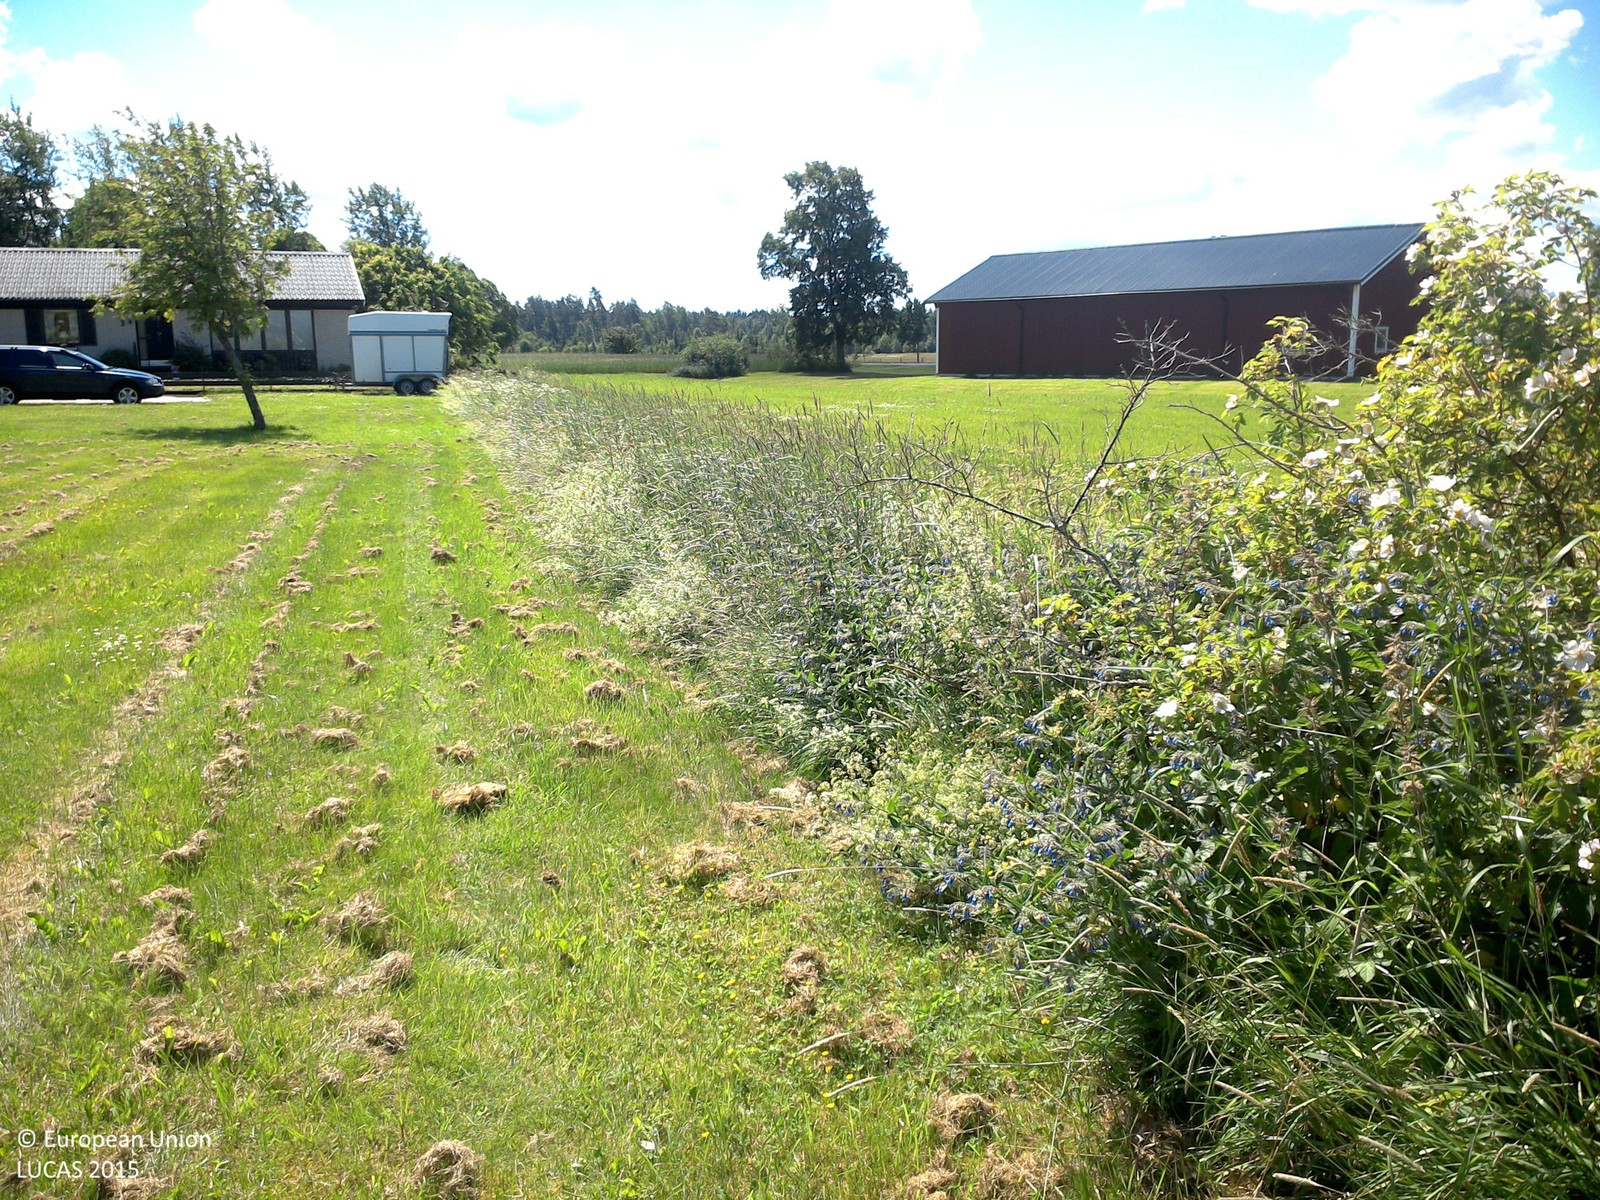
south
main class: Grassland
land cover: Grassland without tree/shrub cover
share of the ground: > 75 %
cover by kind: herbaceous plants 100 %
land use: Amenities, museums, leisure
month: July
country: SE
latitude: 58.3989
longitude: 15.4182
